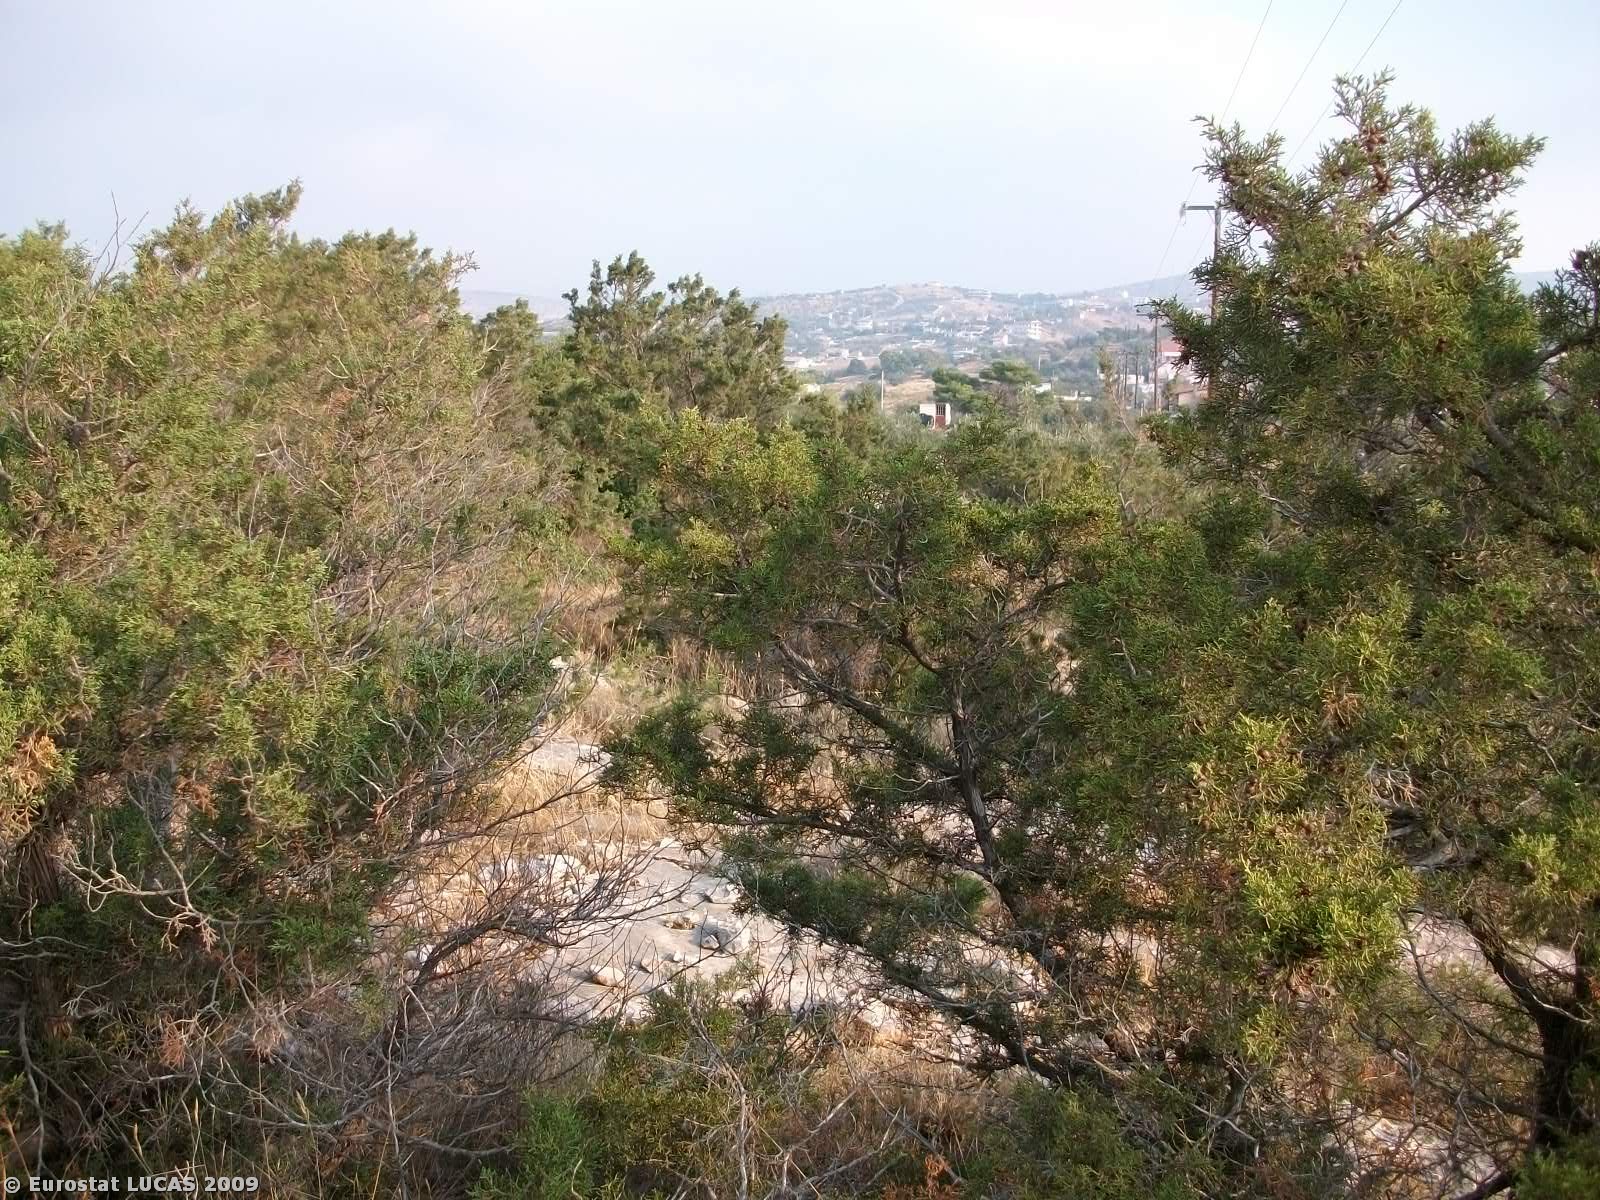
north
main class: Shrubland
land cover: Shrubland with sparse tree cover
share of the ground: 50 - 75 %
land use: Unused
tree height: < 5 m
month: October
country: GR
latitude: 37.8270
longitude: 23.8746
